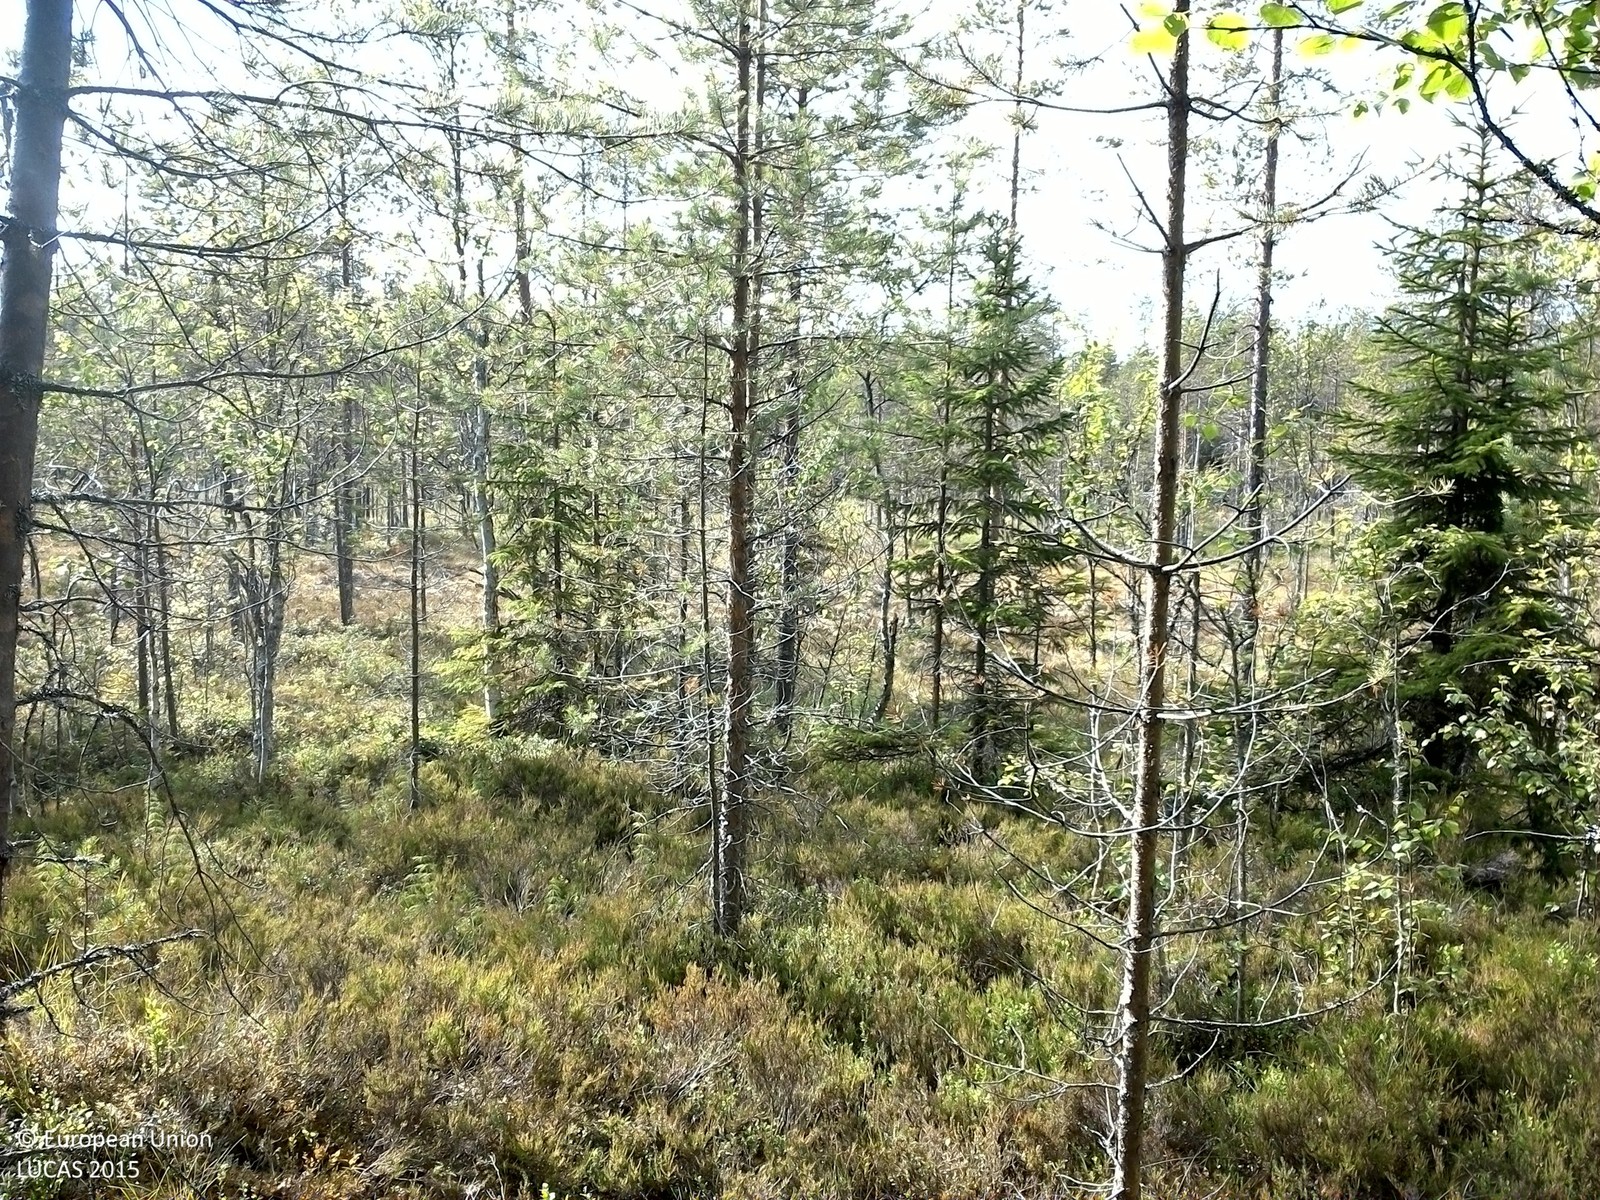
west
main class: Woodland
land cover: Pine dominated coniferous woodland
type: boreal forest
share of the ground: 50 - 75 %
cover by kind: coniferous forest trees 55 %, shrubs 25 %, broadleaved forest trees 10 %, lichens and mosses 10 %
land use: Forestry
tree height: > 5 m
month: August
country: SE
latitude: 63.7944
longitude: 16.4874
